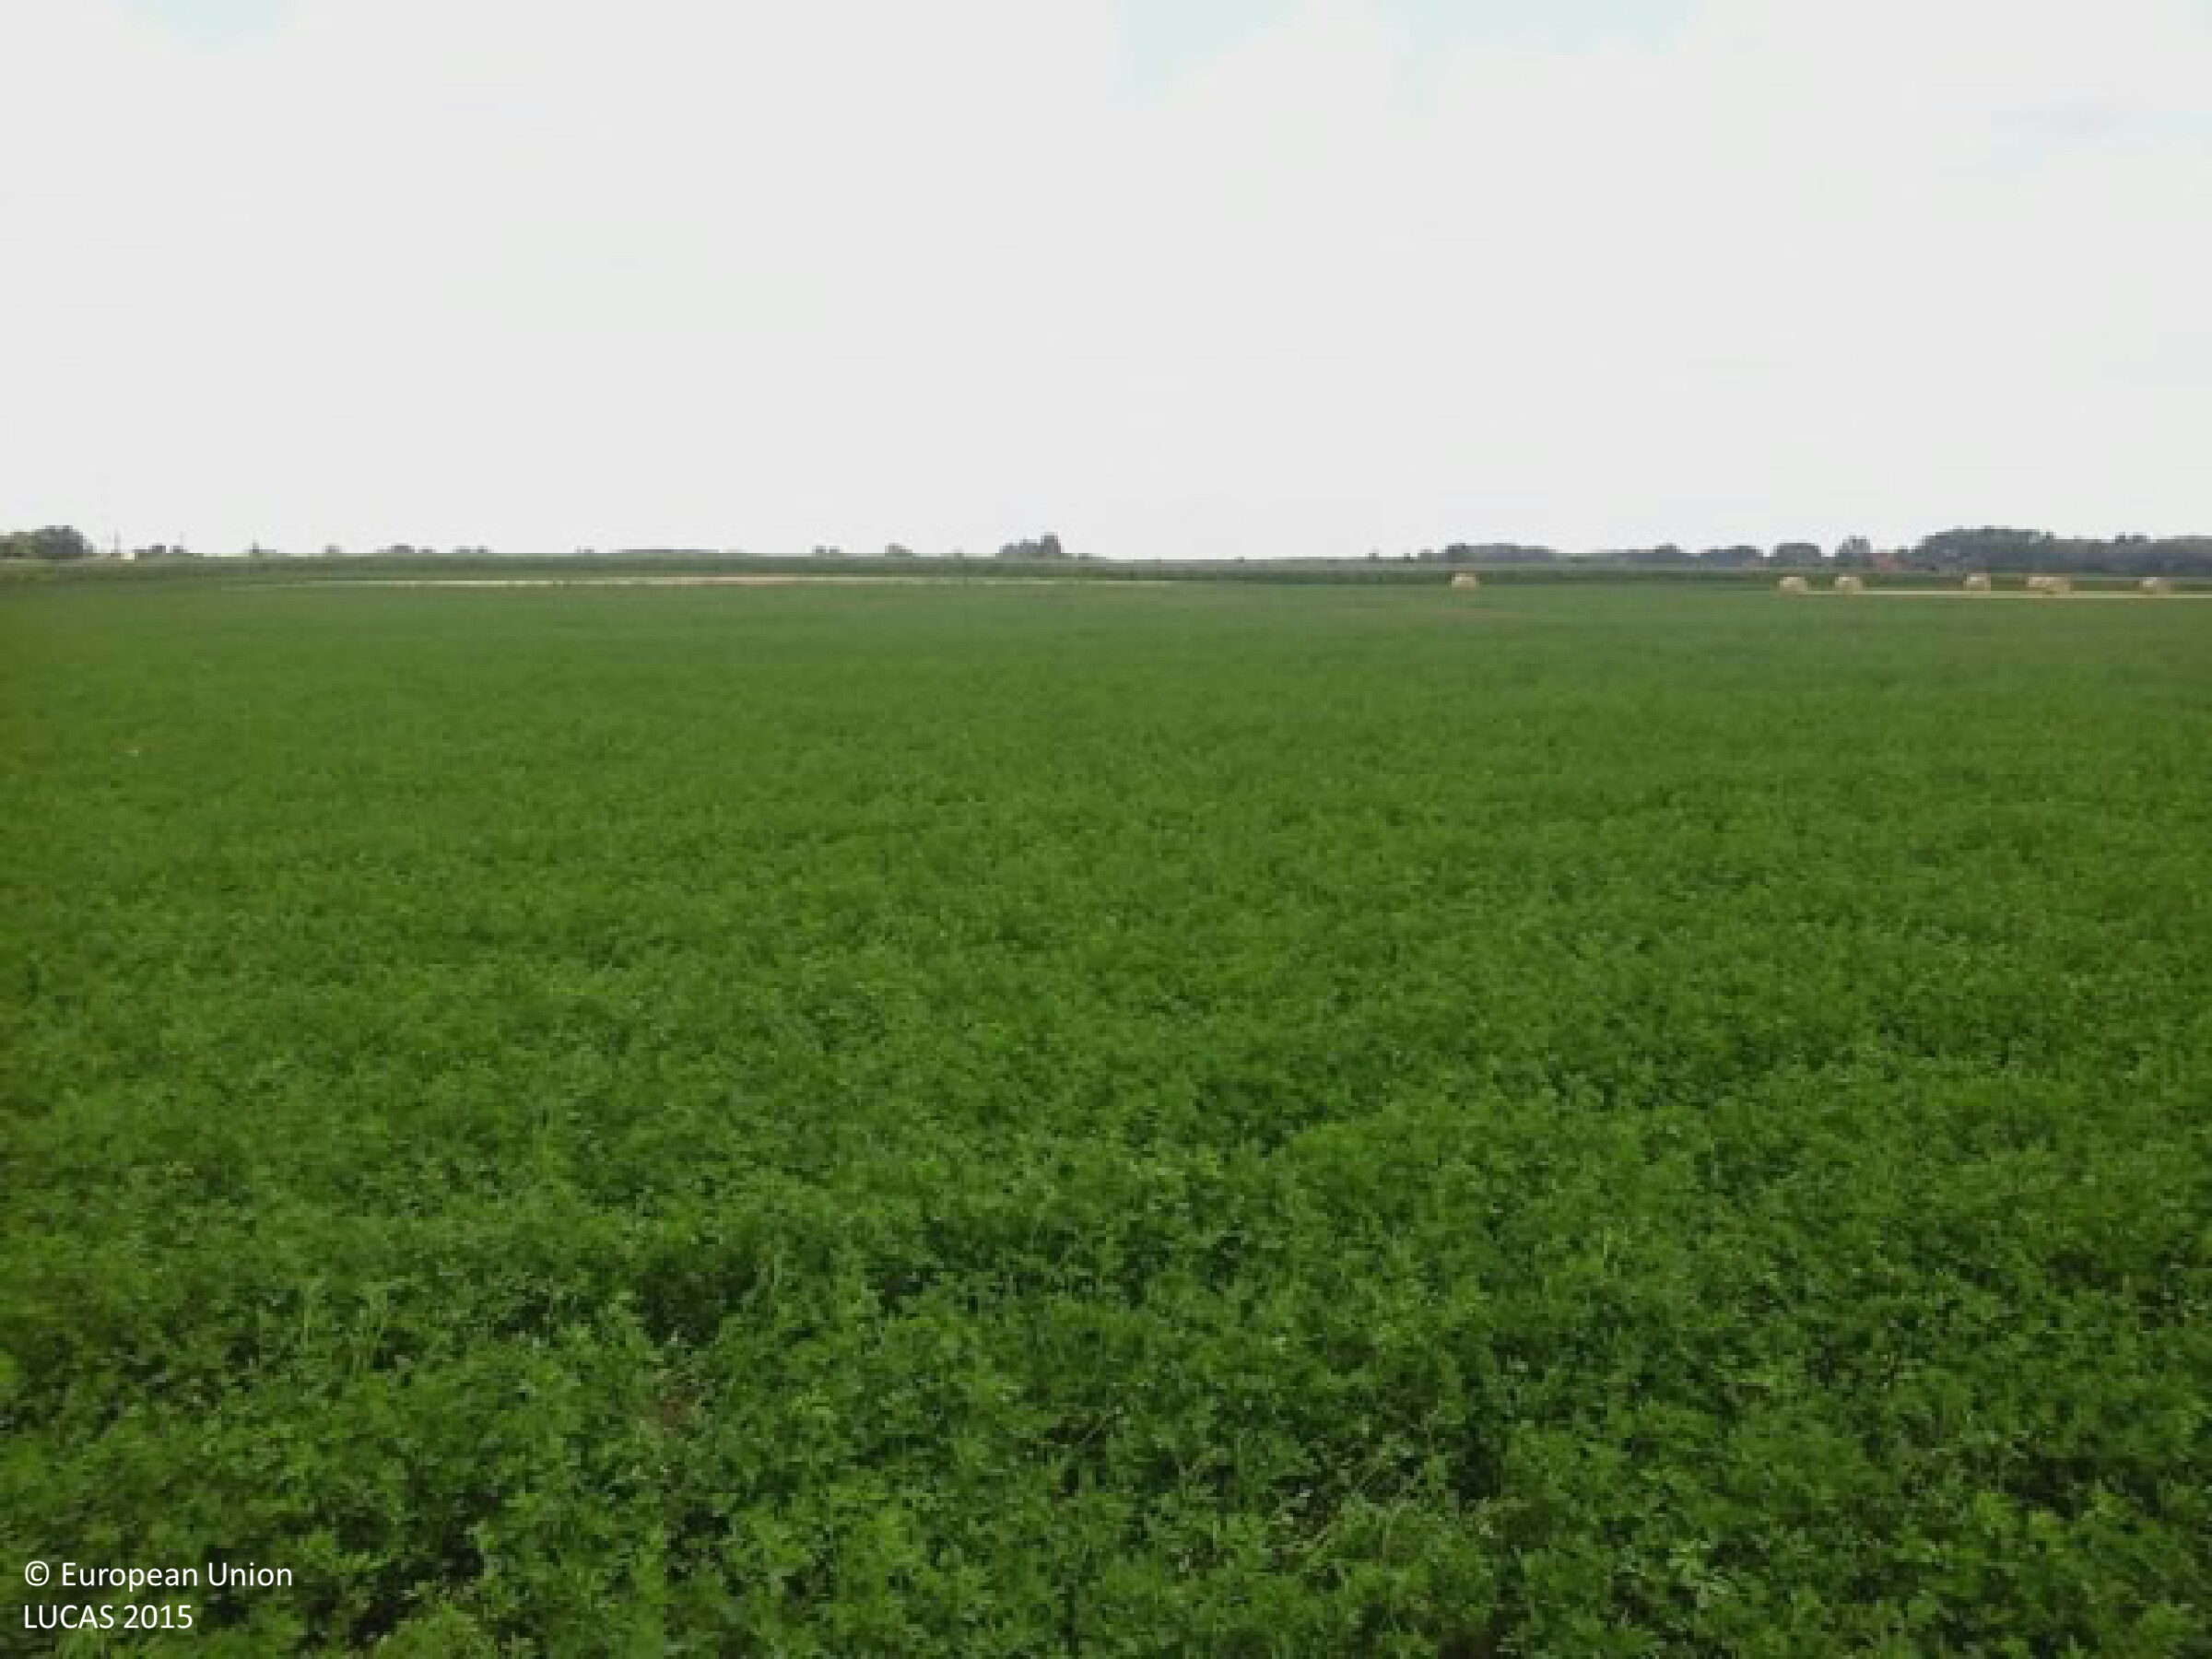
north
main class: Cropland
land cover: Lucerne
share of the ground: > 75 %
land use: Agriculture (excluding fallow land and kitchen gardens)
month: July
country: HU
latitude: 47.6157
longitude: 21.3636
